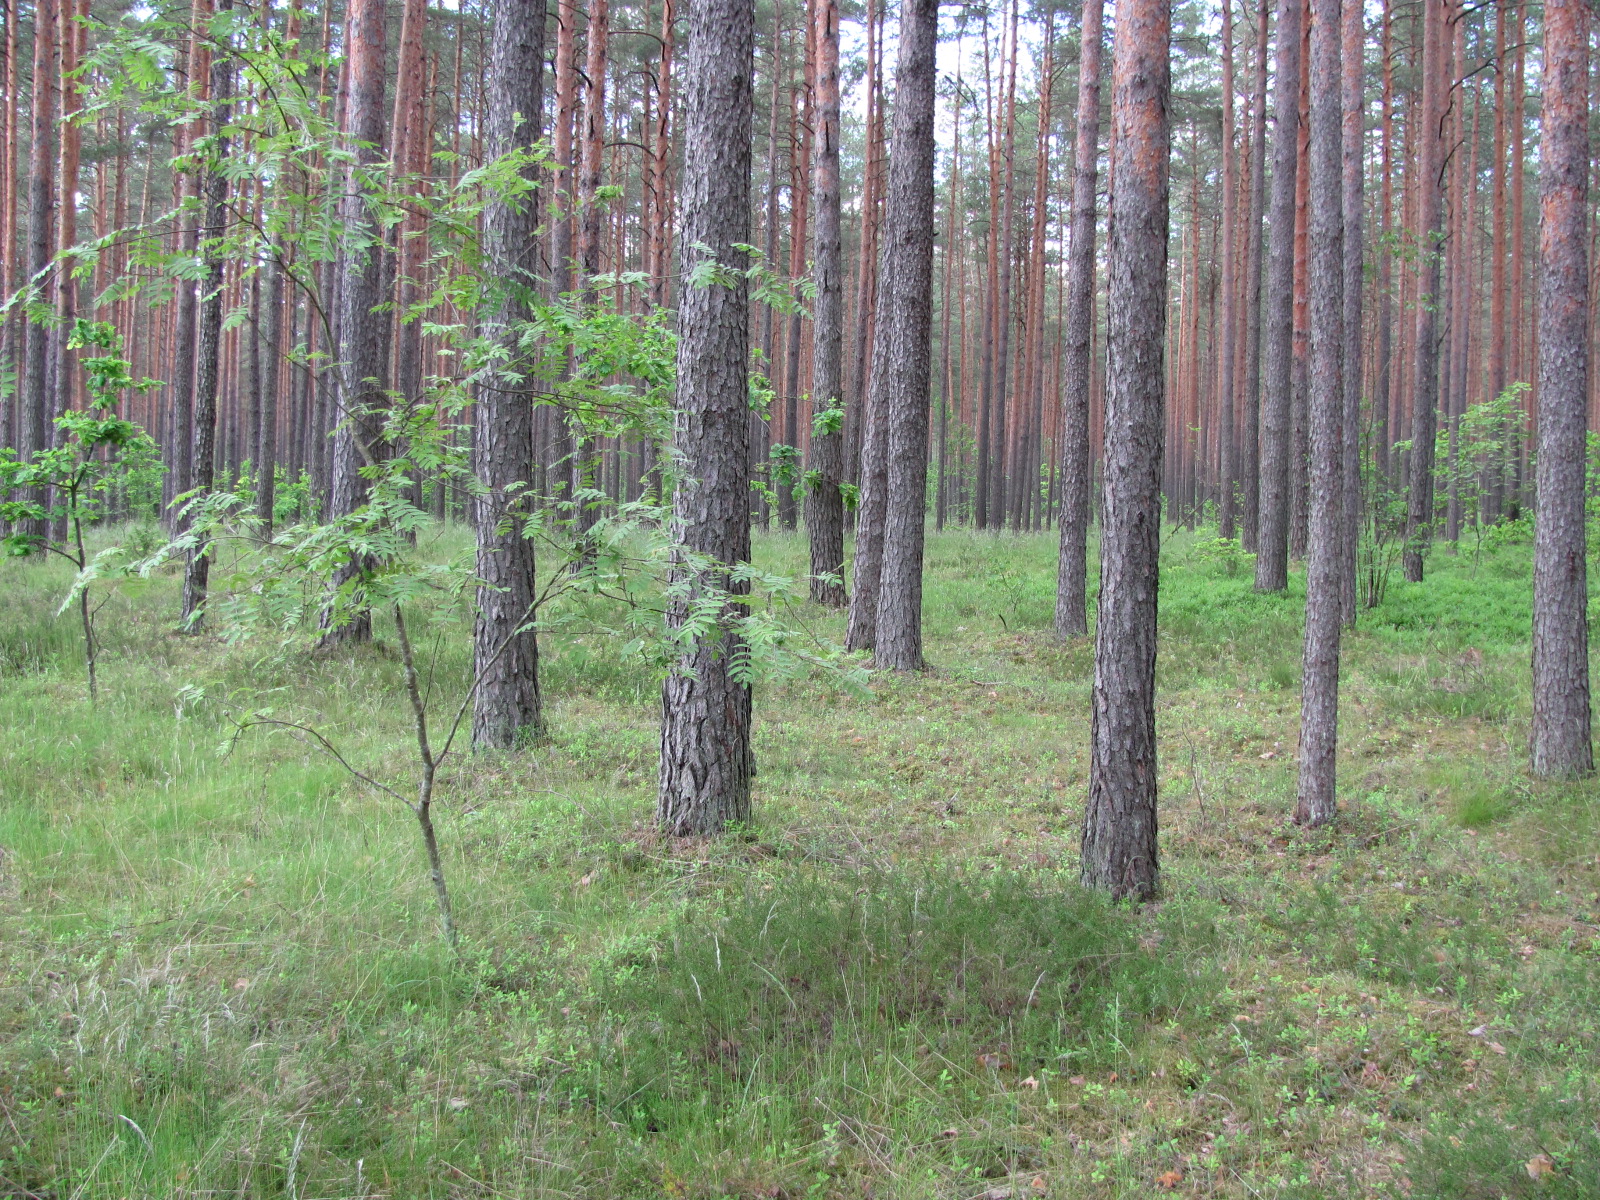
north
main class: Woodland
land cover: Pine dominated coniferous woodland
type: hemiboreal forest and nemoral coniferous forest and mixed broadleaved-coniferous forest
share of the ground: > 75 %
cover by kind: coniferous forest trees 85 %, lichens and mosses 10 %, herbaceous plants 5 %
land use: Forestry
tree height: > 5 m
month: June
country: LV
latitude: 56.9534
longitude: 24.3122
